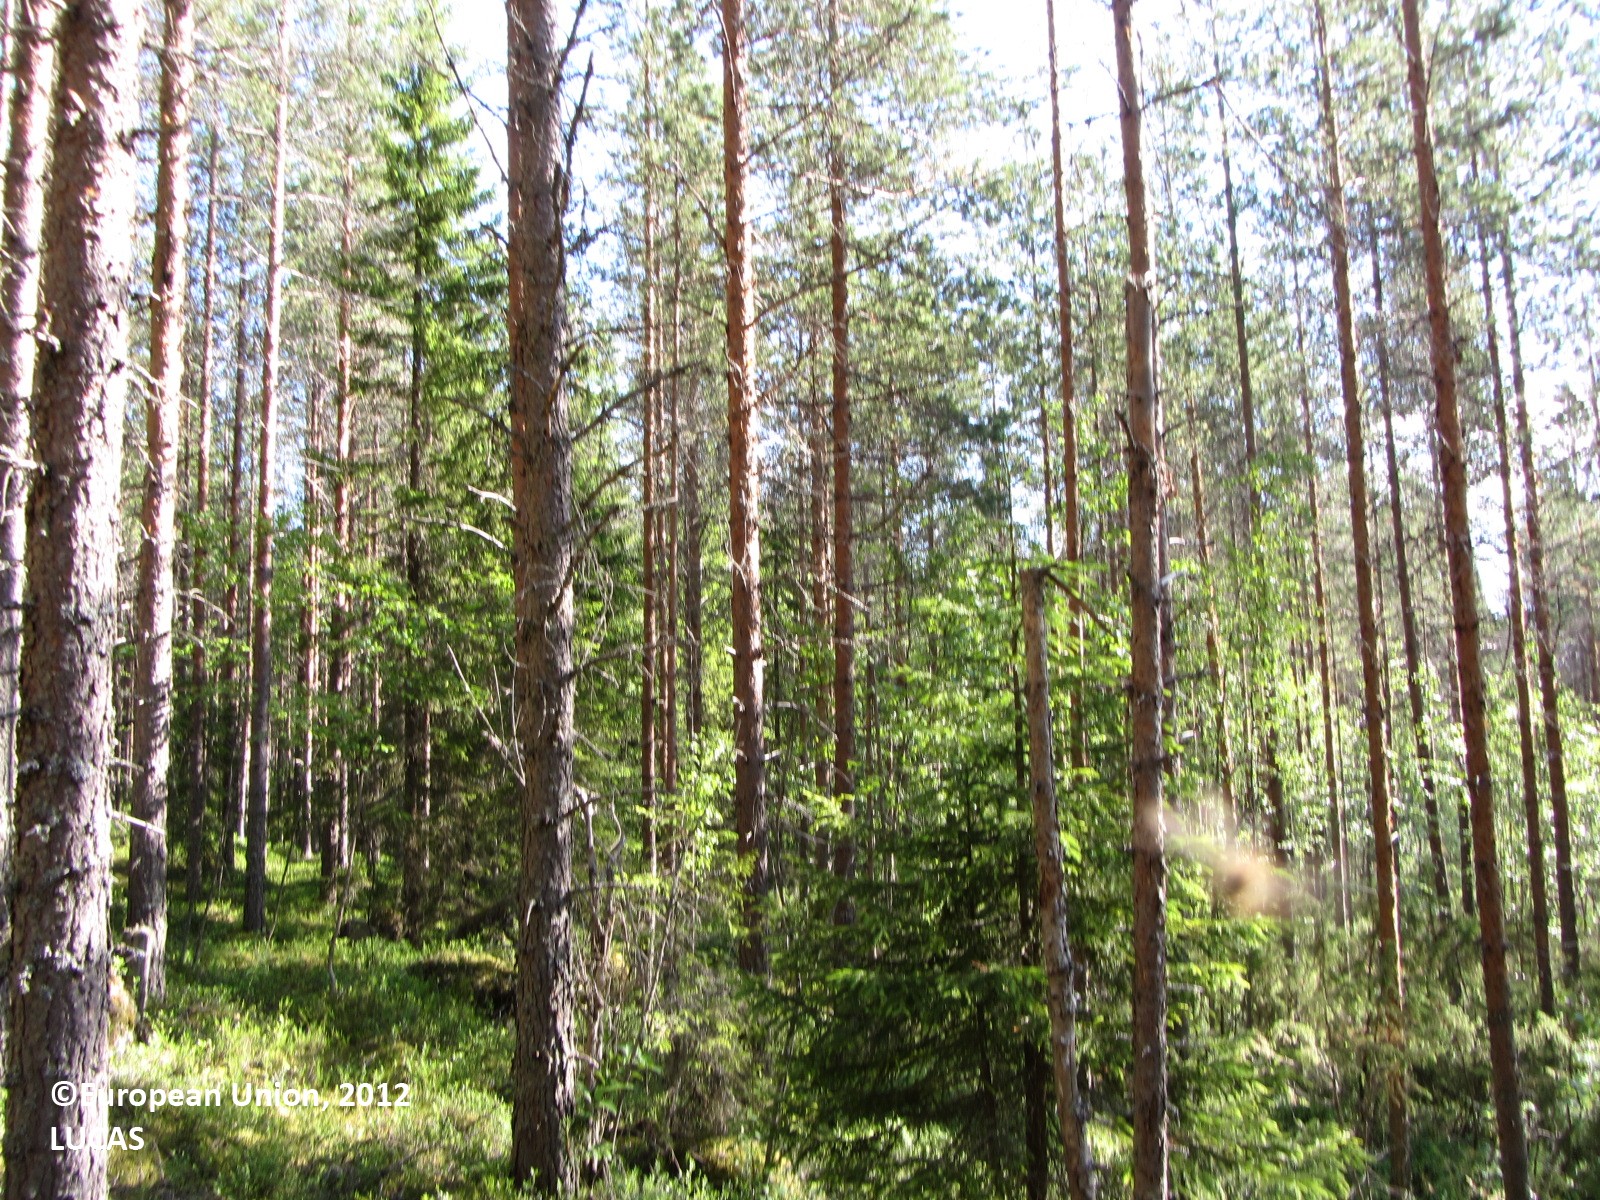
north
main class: Woodland
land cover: Pine dominated coniferous woodland
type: boreal forest
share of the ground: 25 - 50 %
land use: Forestry
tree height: > 5 m
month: July
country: FI
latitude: 62.8142
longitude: 25.3491
